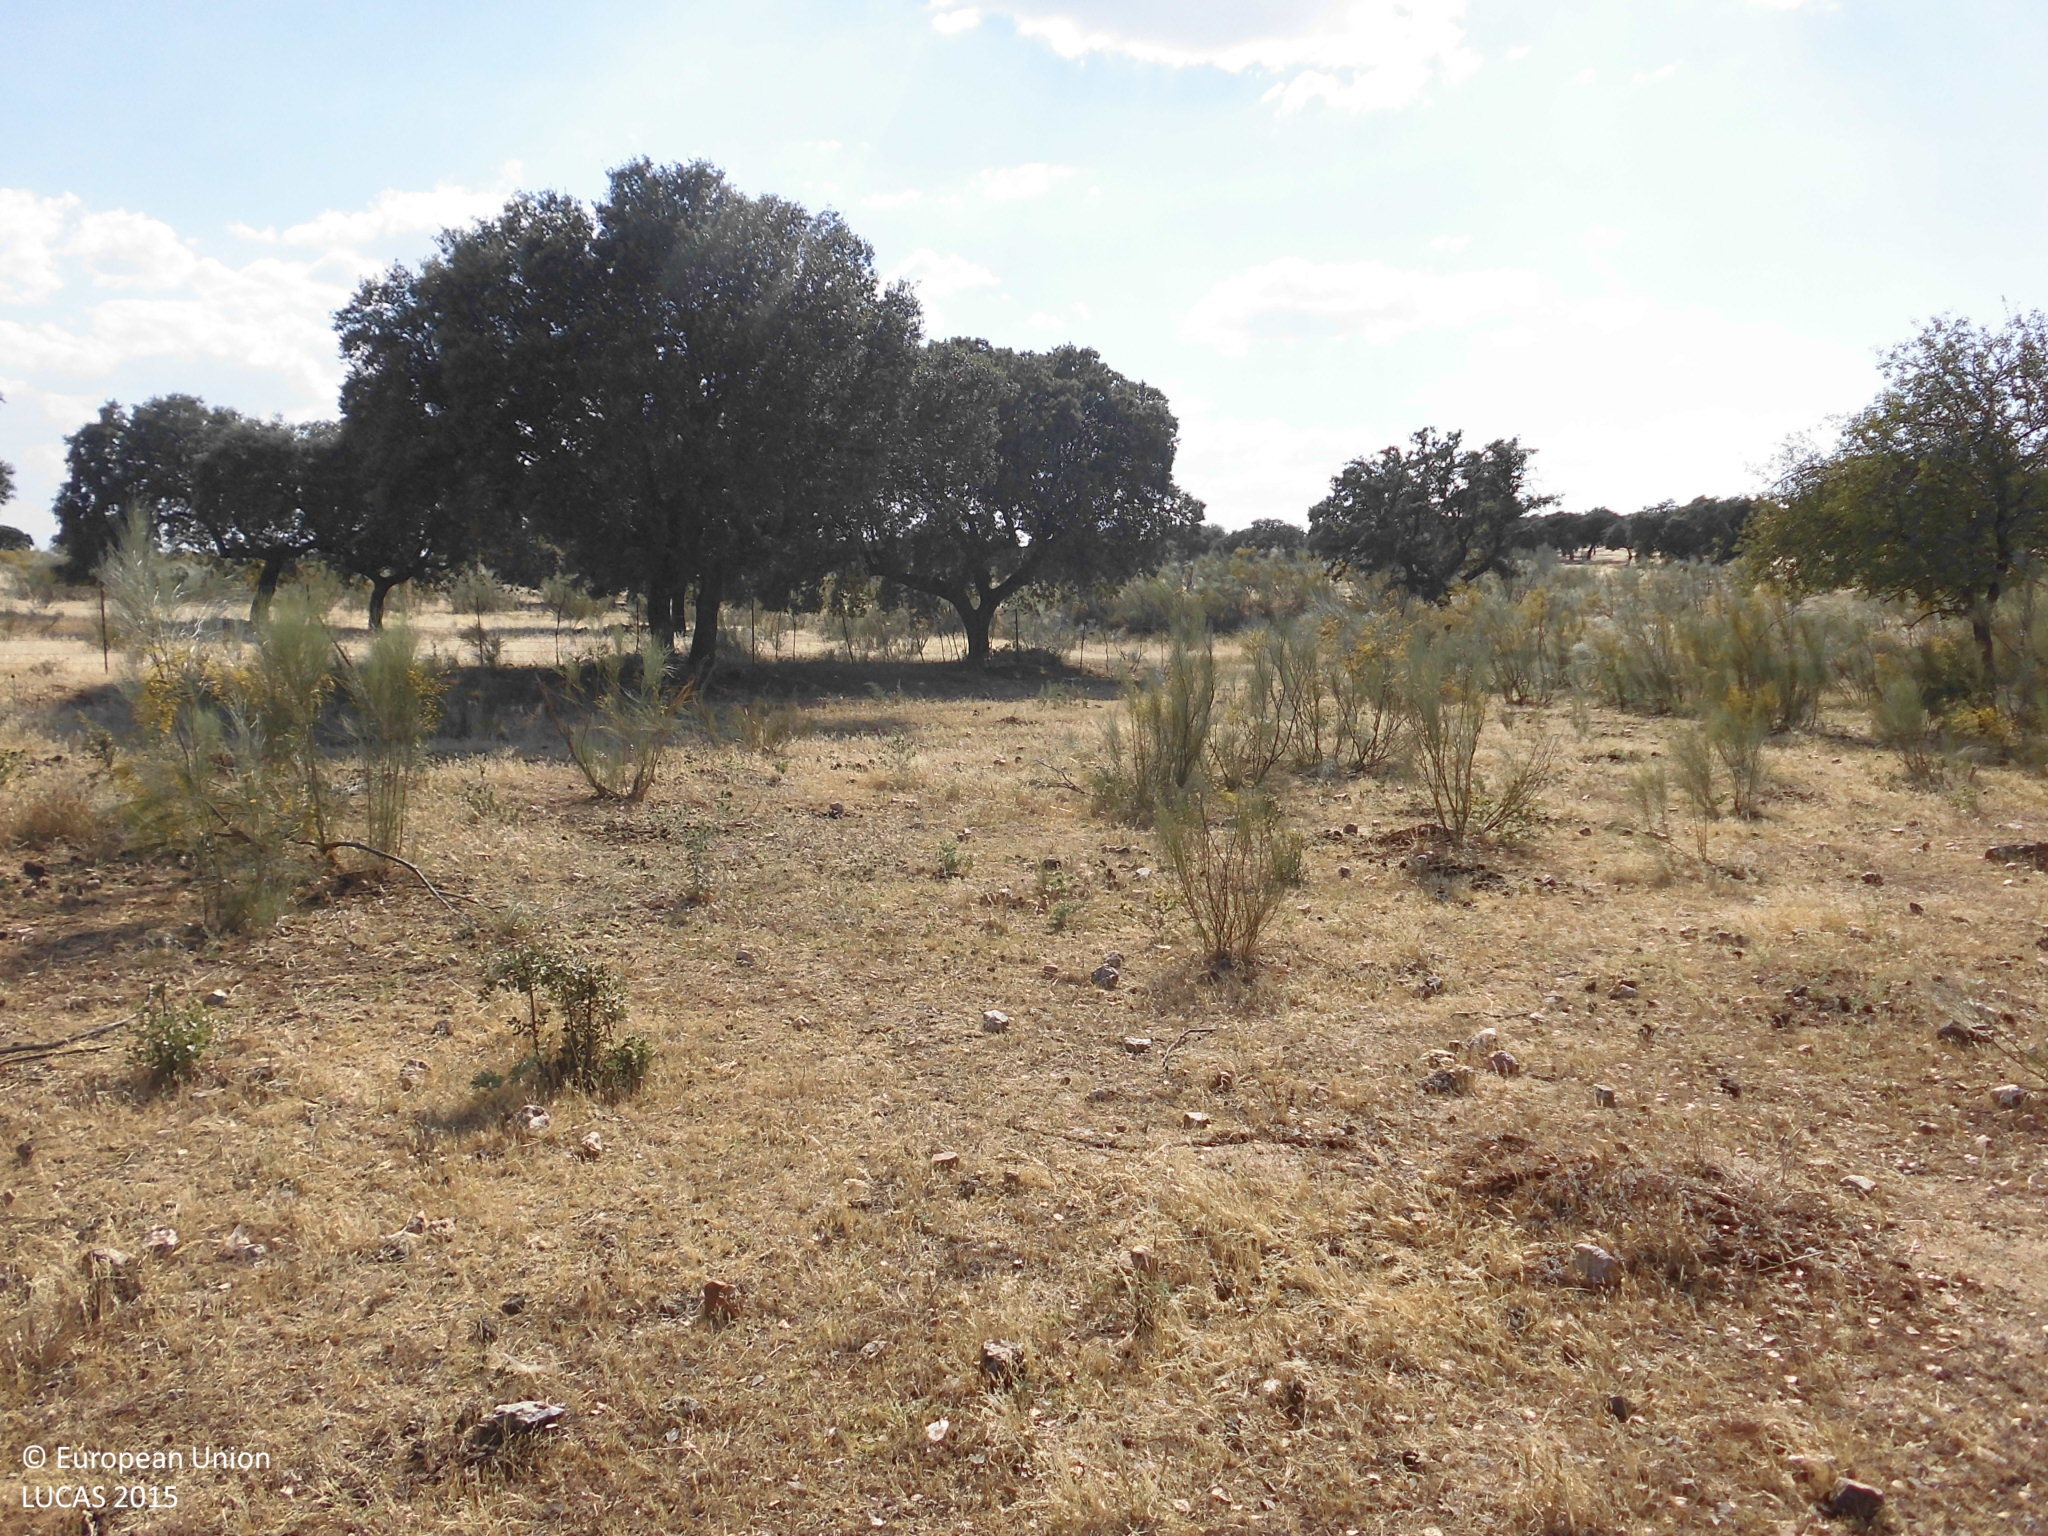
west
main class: Woodland
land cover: Broadleaved woodland
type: broadleaved evergreen forest
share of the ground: 25 - 50 %
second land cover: Grassland without tree/shrub cover
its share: > 75 %
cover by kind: herbaceous plants 55 %, broadleaved forest trees 35 %, shrubs 5 %
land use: Forestry
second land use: Agriculture (excluding fallow land and kitchen gardens)
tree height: > 5 m
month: May
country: ES
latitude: 39.6877
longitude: -6.5037
